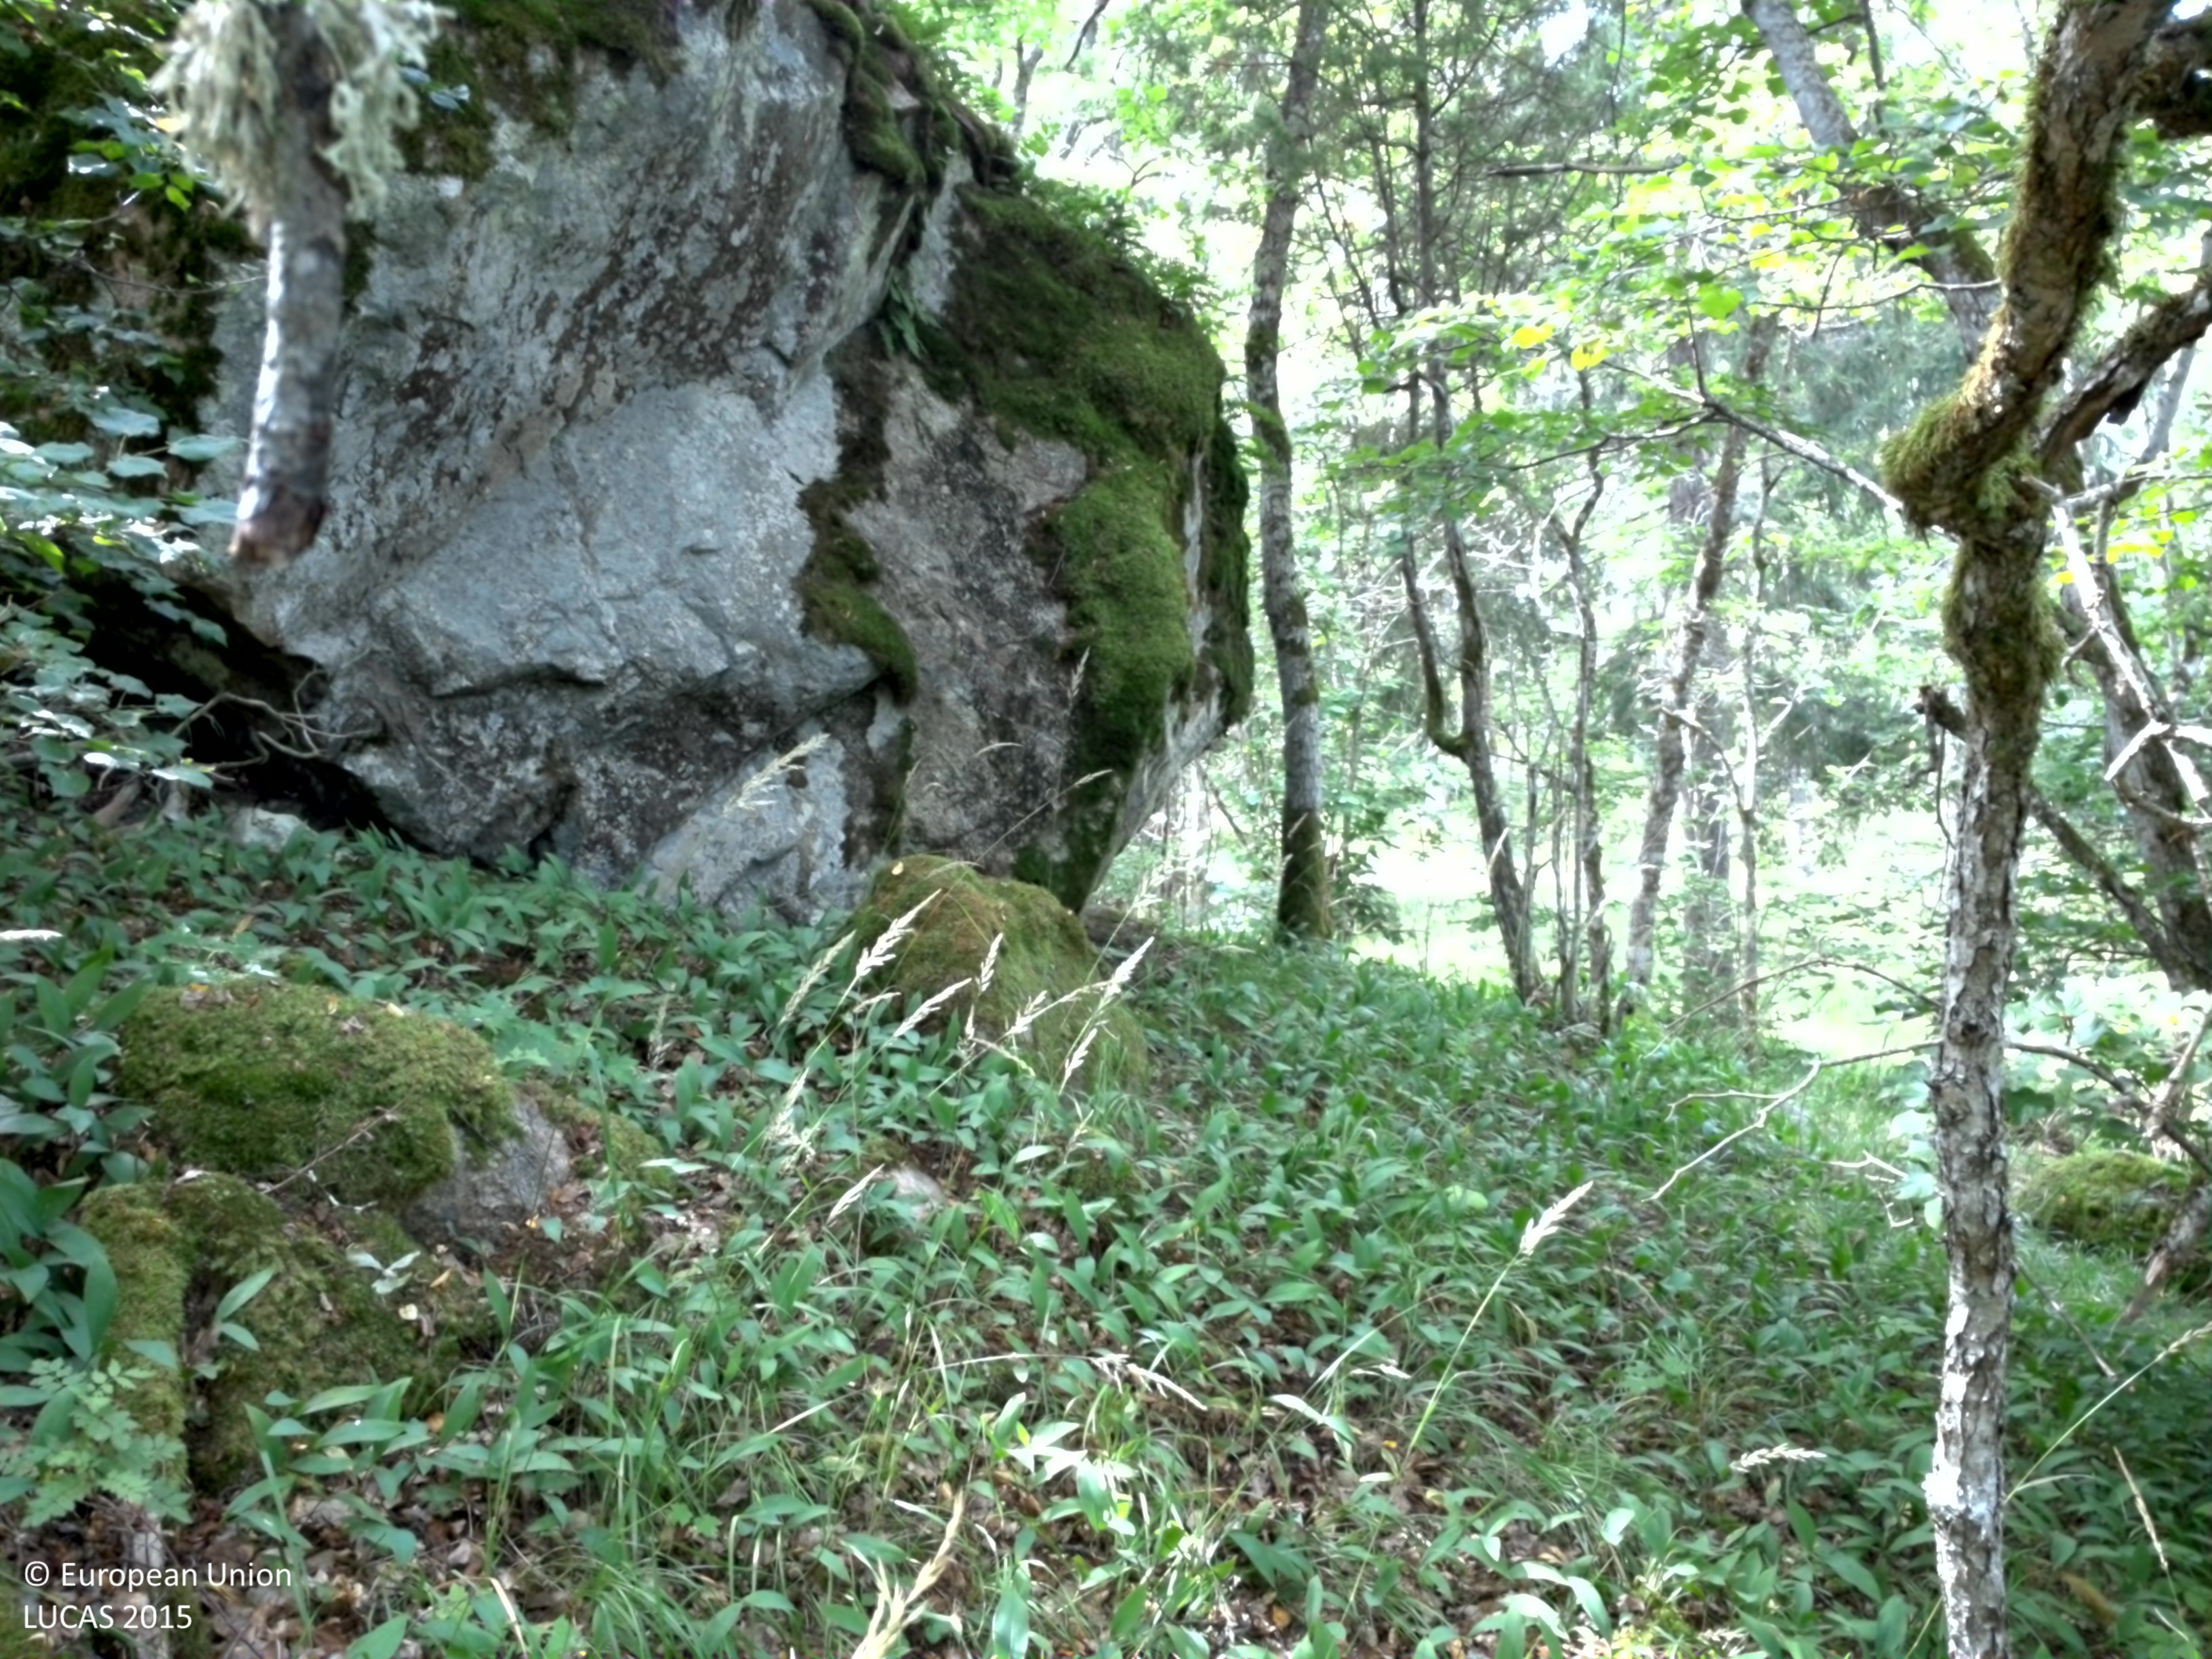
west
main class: Woodland
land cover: Broadleaved woodland
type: hemiboreal forest and nemoral coniferous forest and mixed broadleaved-coniferous forest
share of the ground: > 75 %
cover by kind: broadleaved forest trees 80 %, herbaceous plants 15 %, shrubs 5 %
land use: Forestry
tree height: > 5 m
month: August
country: SE
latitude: 59.8820
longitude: 17.9820
